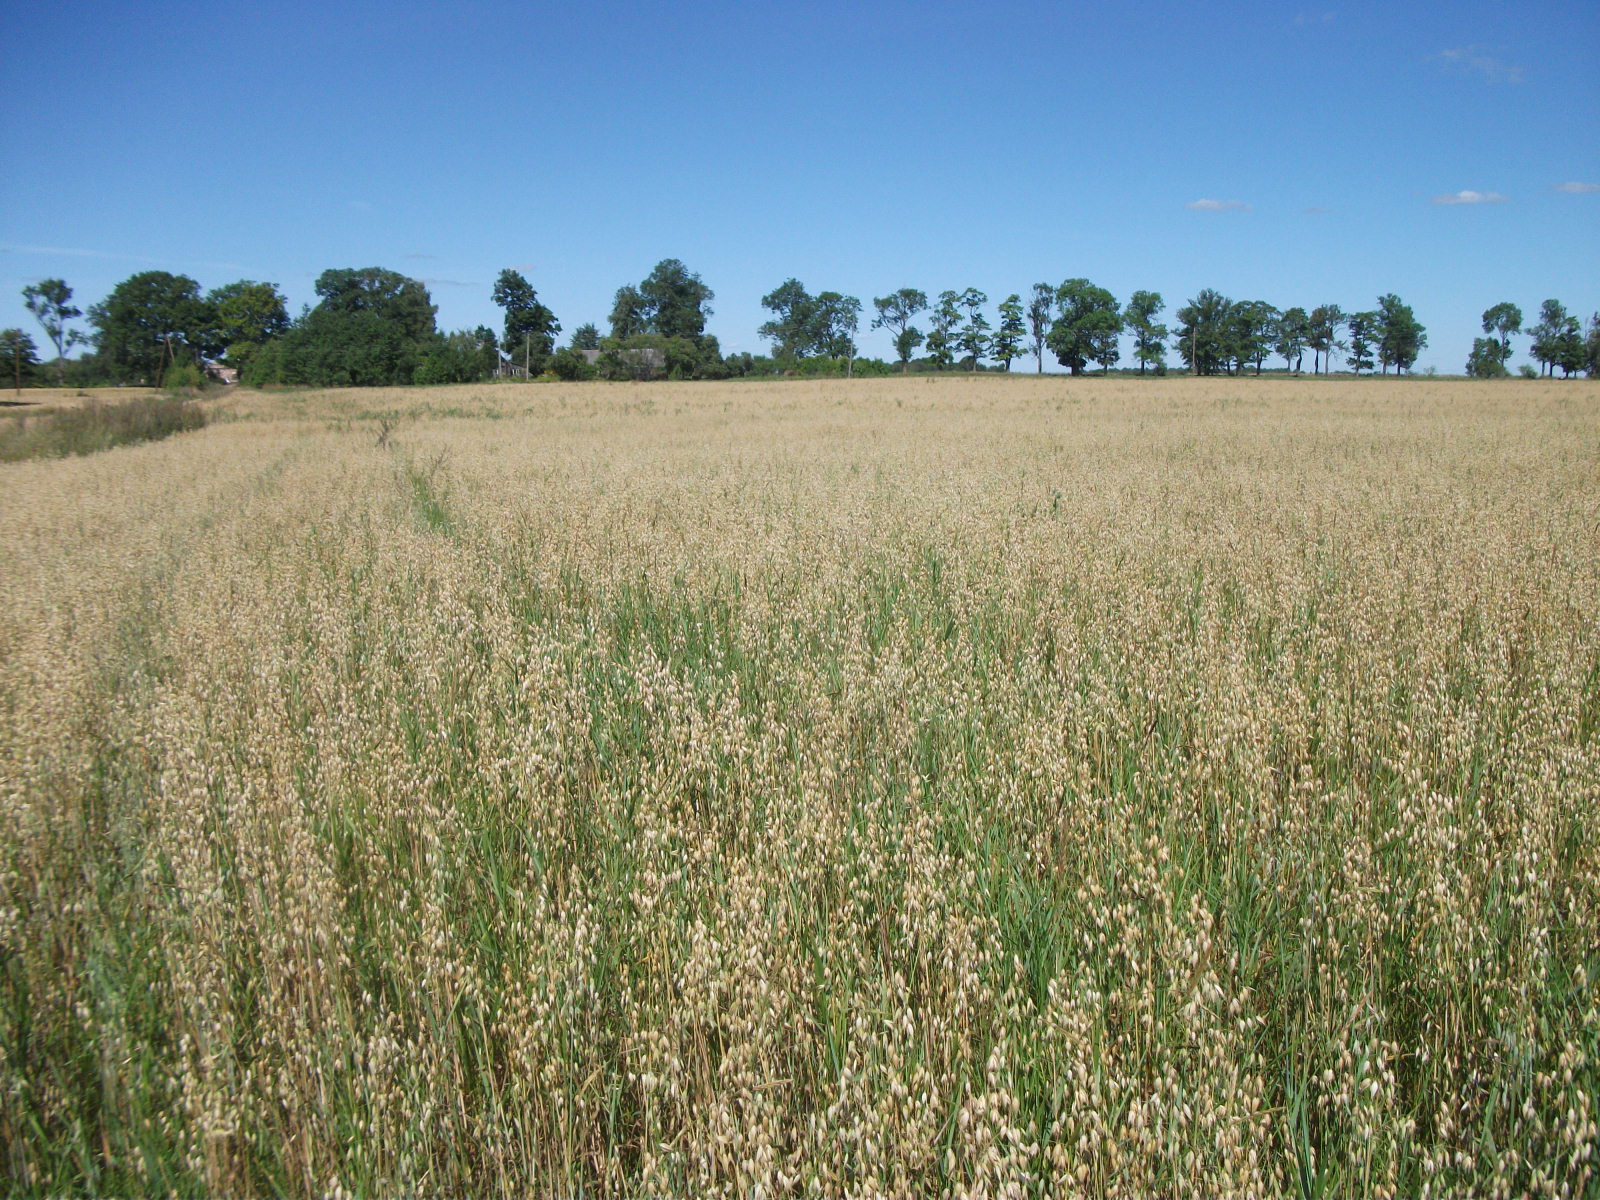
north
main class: Cropland
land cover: Oats
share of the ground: > 75 %
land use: Agriculture (excluding fallow land and kitchen gardens)
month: August
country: LV
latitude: 56.6673
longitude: 26.1104
